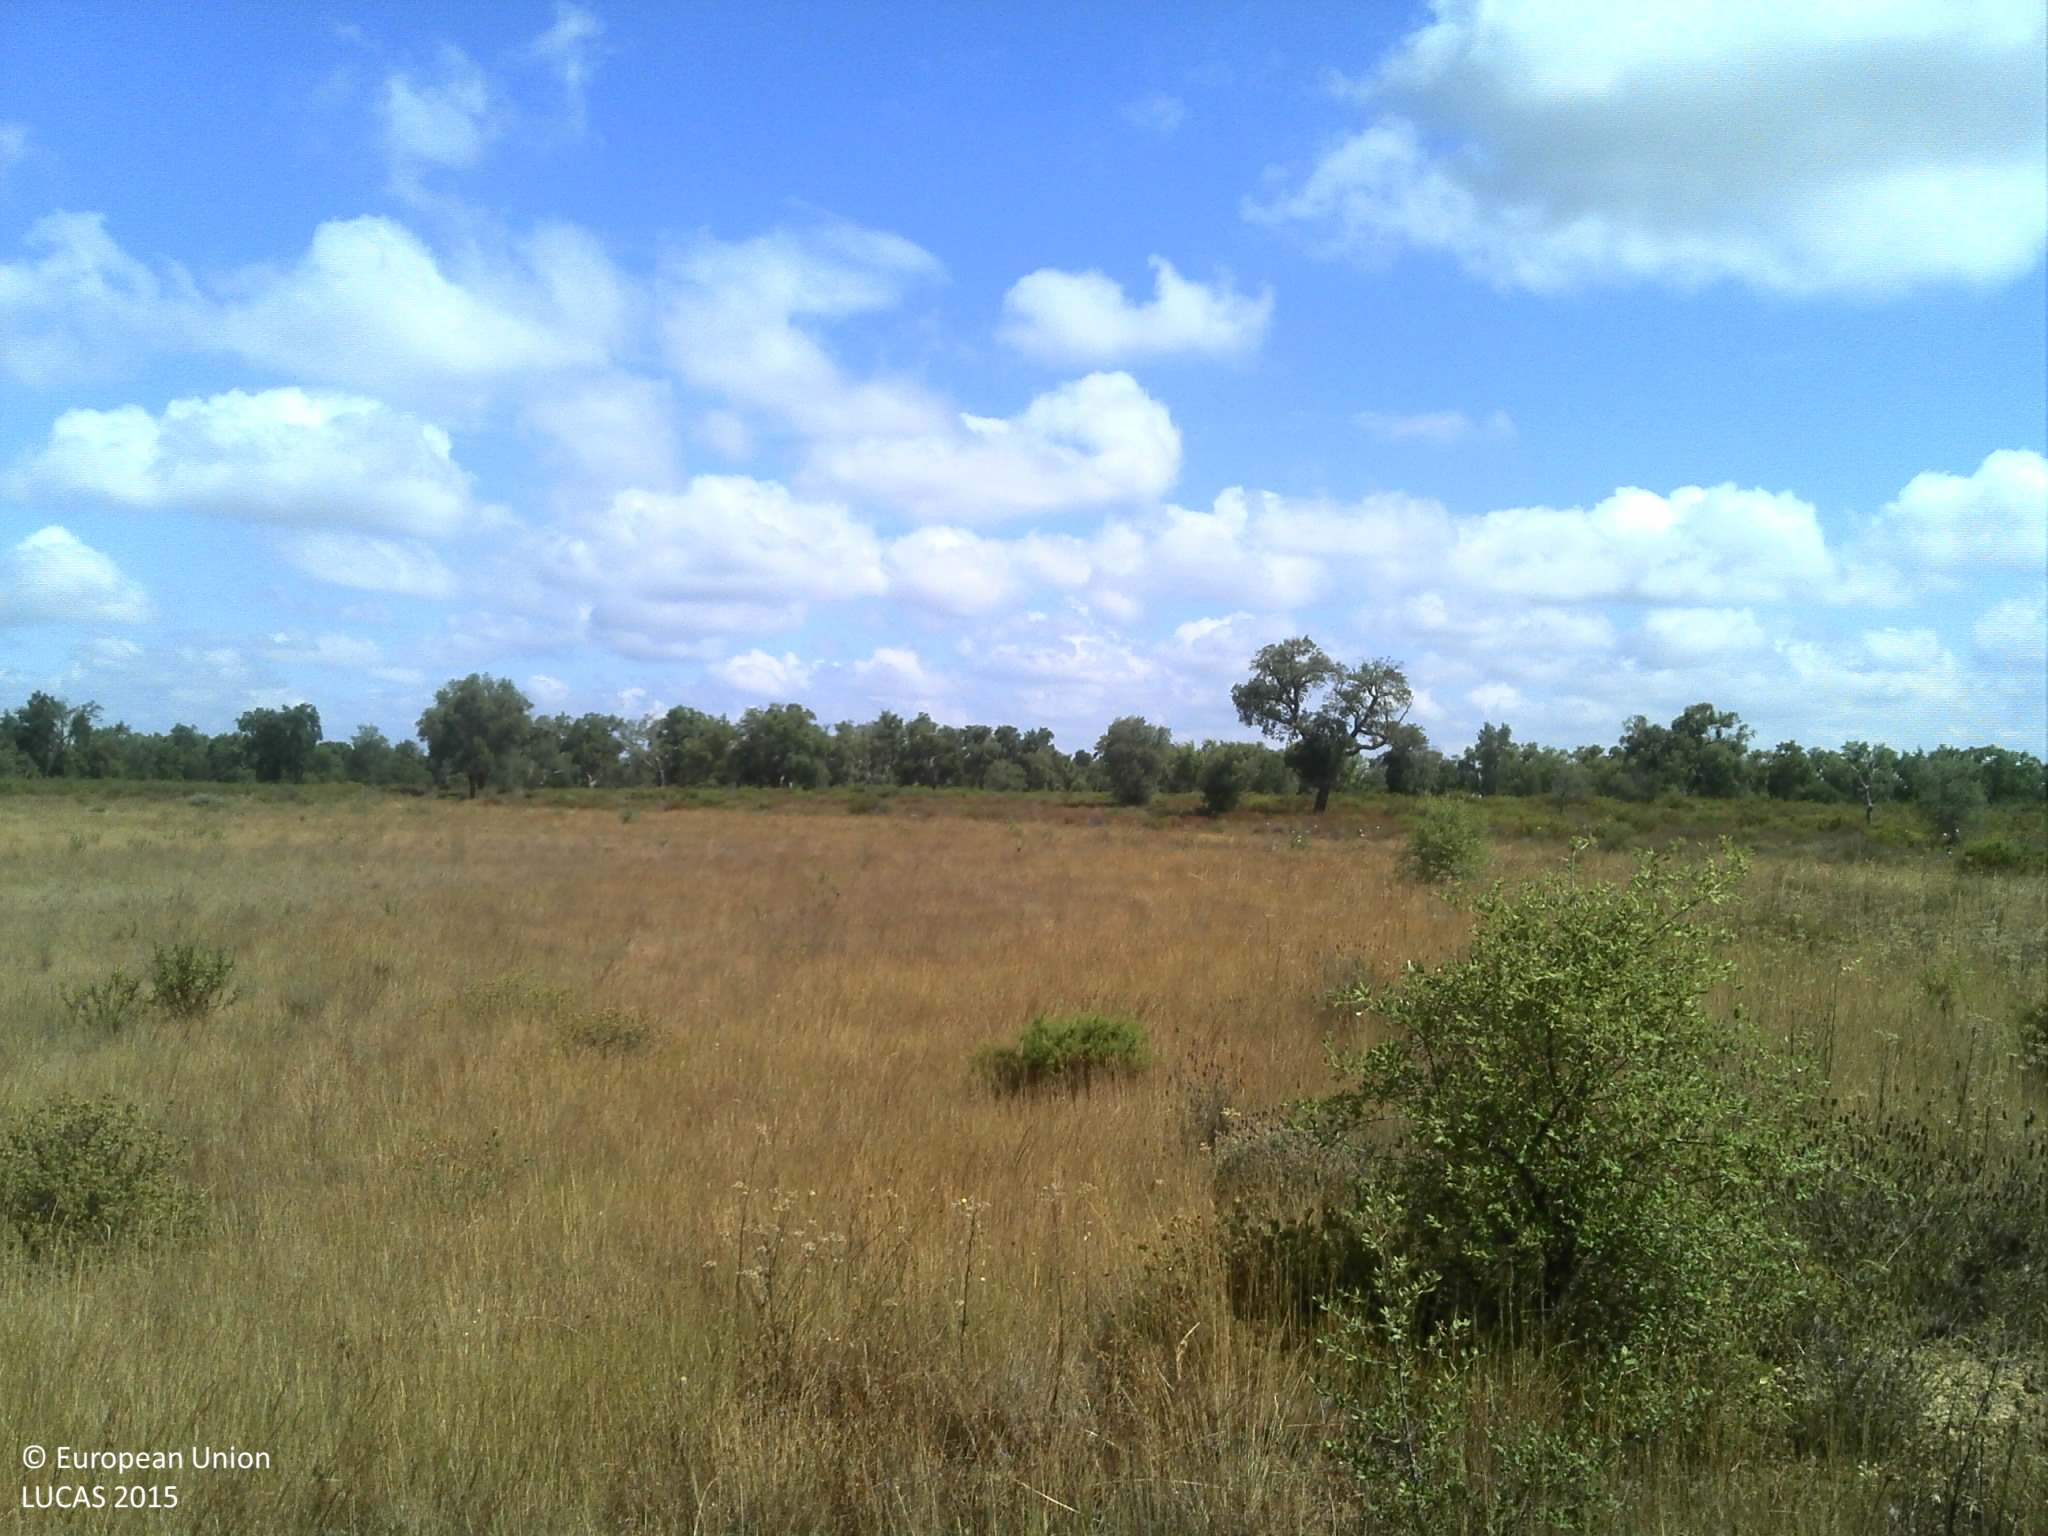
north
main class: Grassland
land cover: Grassland without tree/shrub cover
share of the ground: 50 - 75 %
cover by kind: herbaceous plants 75 %, consolidated bare surface 25 %
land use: Agriculture (excluding fallow land and kitchen gardens)
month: June
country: PT
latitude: 39.3182
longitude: -8.2374
